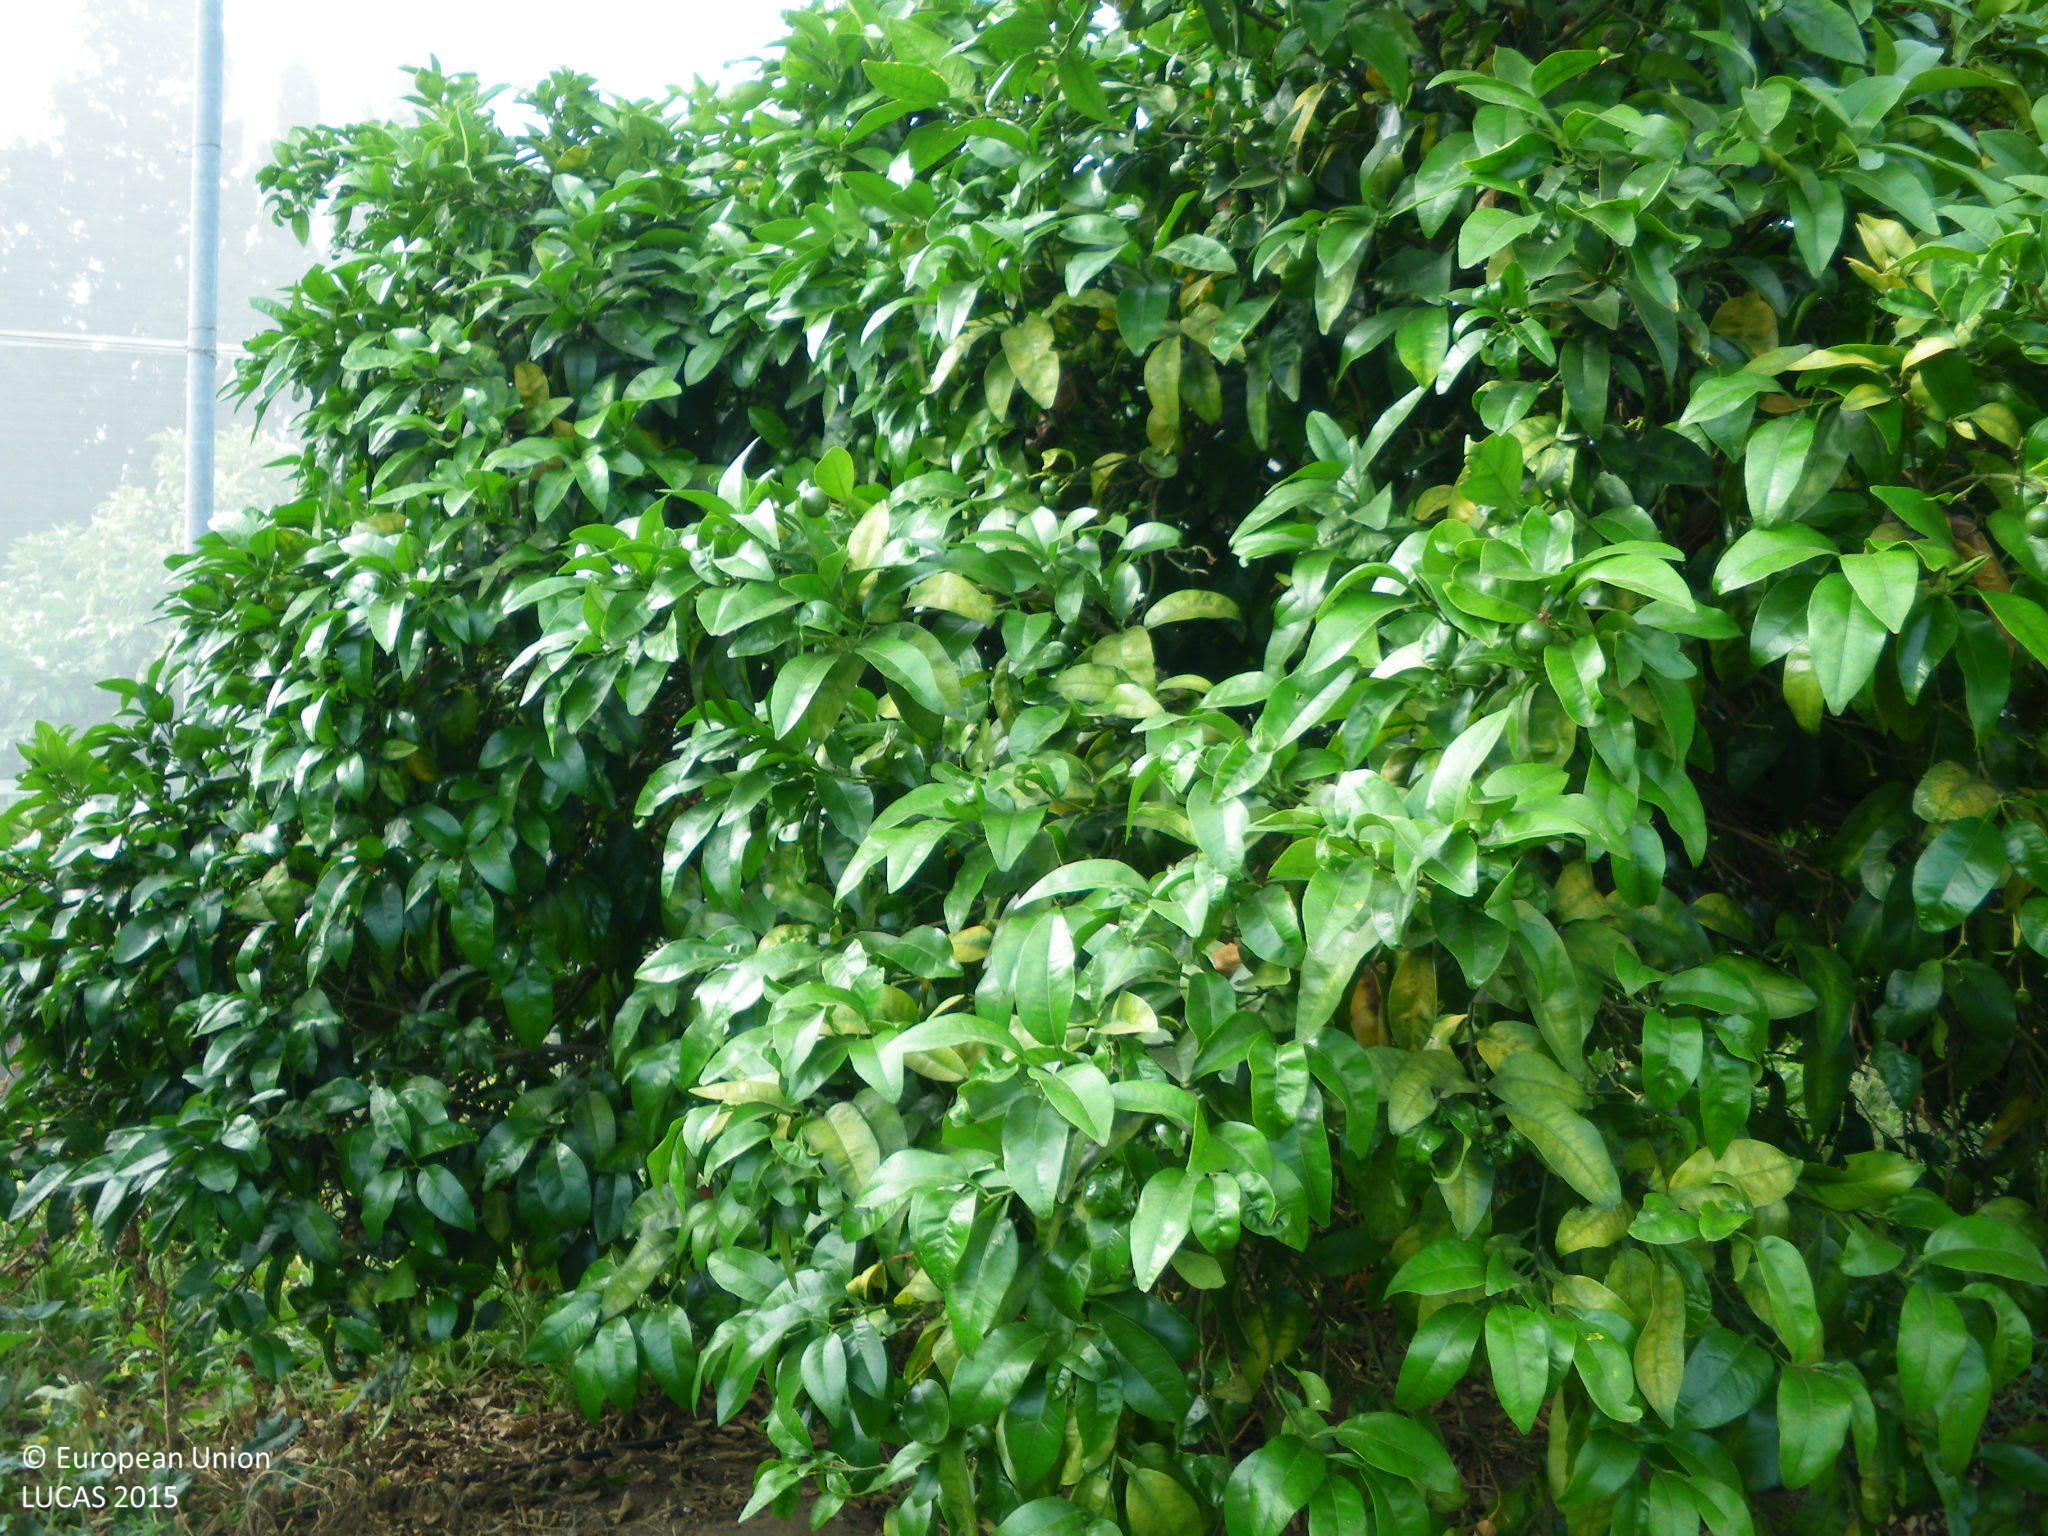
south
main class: Cropland
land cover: Other citrus fruit
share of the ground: 25 - 50 %
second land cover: Spontaneously vegetated surfaces
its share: > 75 %
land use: Agriculture (excluding fallow land and kitchen gardens)
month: June
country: ES
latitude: 36.3094
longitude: -5.8936
